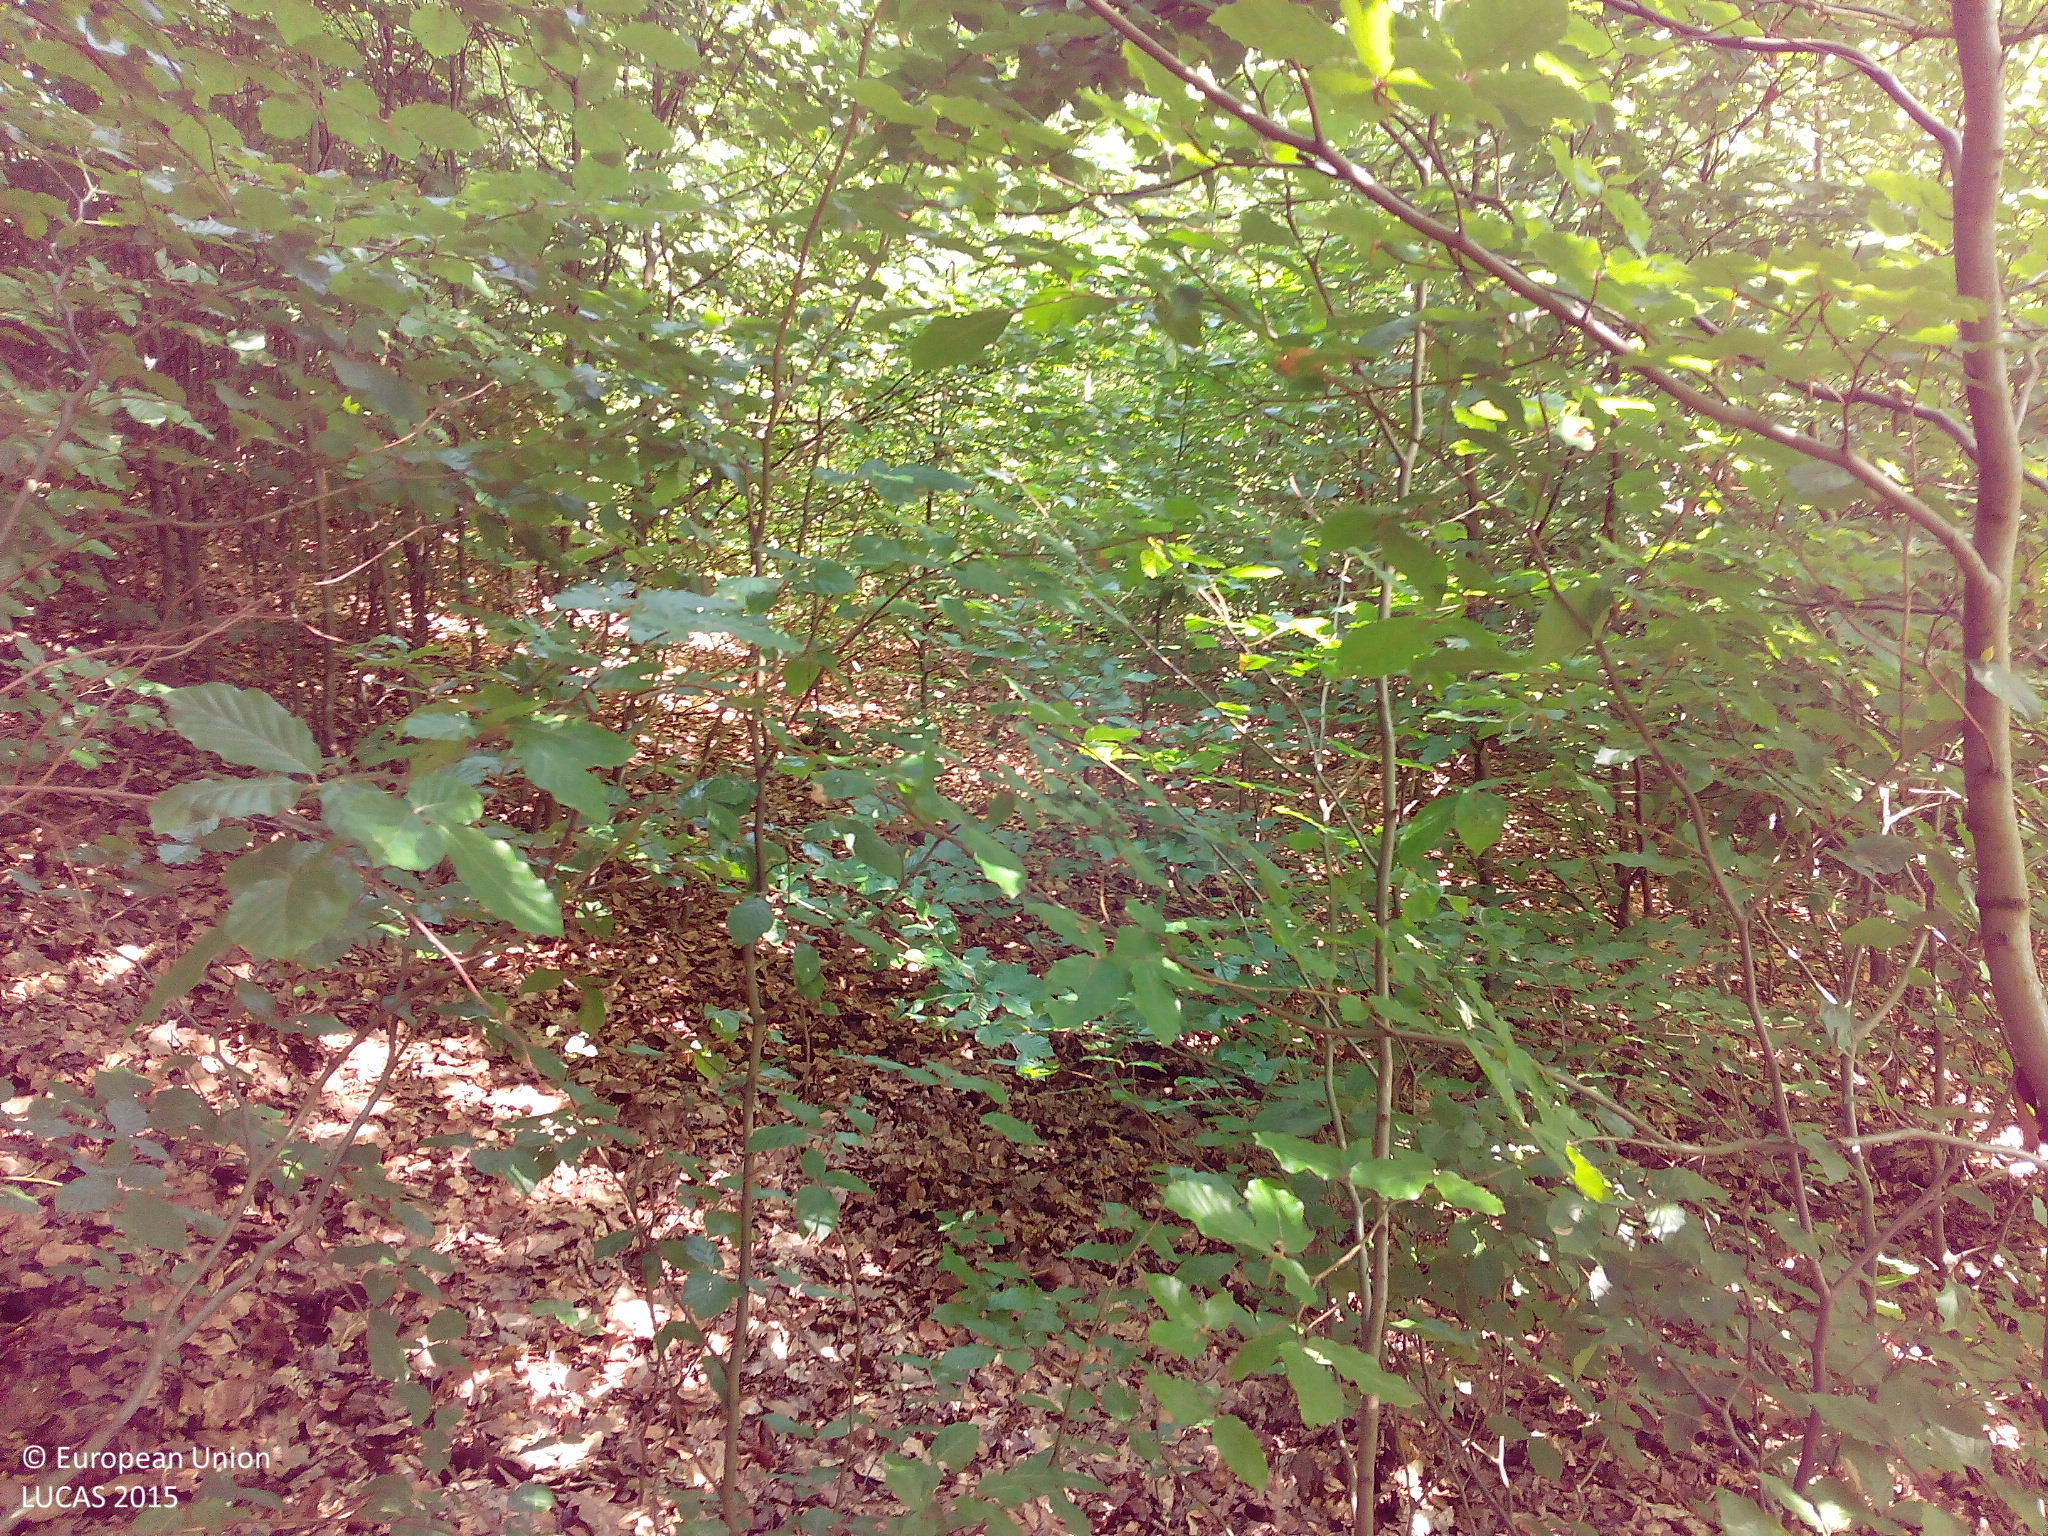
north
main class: Woodland
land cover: Broadleaved woodland
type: beech forest
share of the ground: > 75 %
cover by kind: broadleaved forest trees 80 %, herbaceous plants 15 %, unconsolidated bare surface 5 %
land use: Forestry
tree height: > 5 m
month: July
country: DE
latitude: 50.9033
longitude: 9.8436
